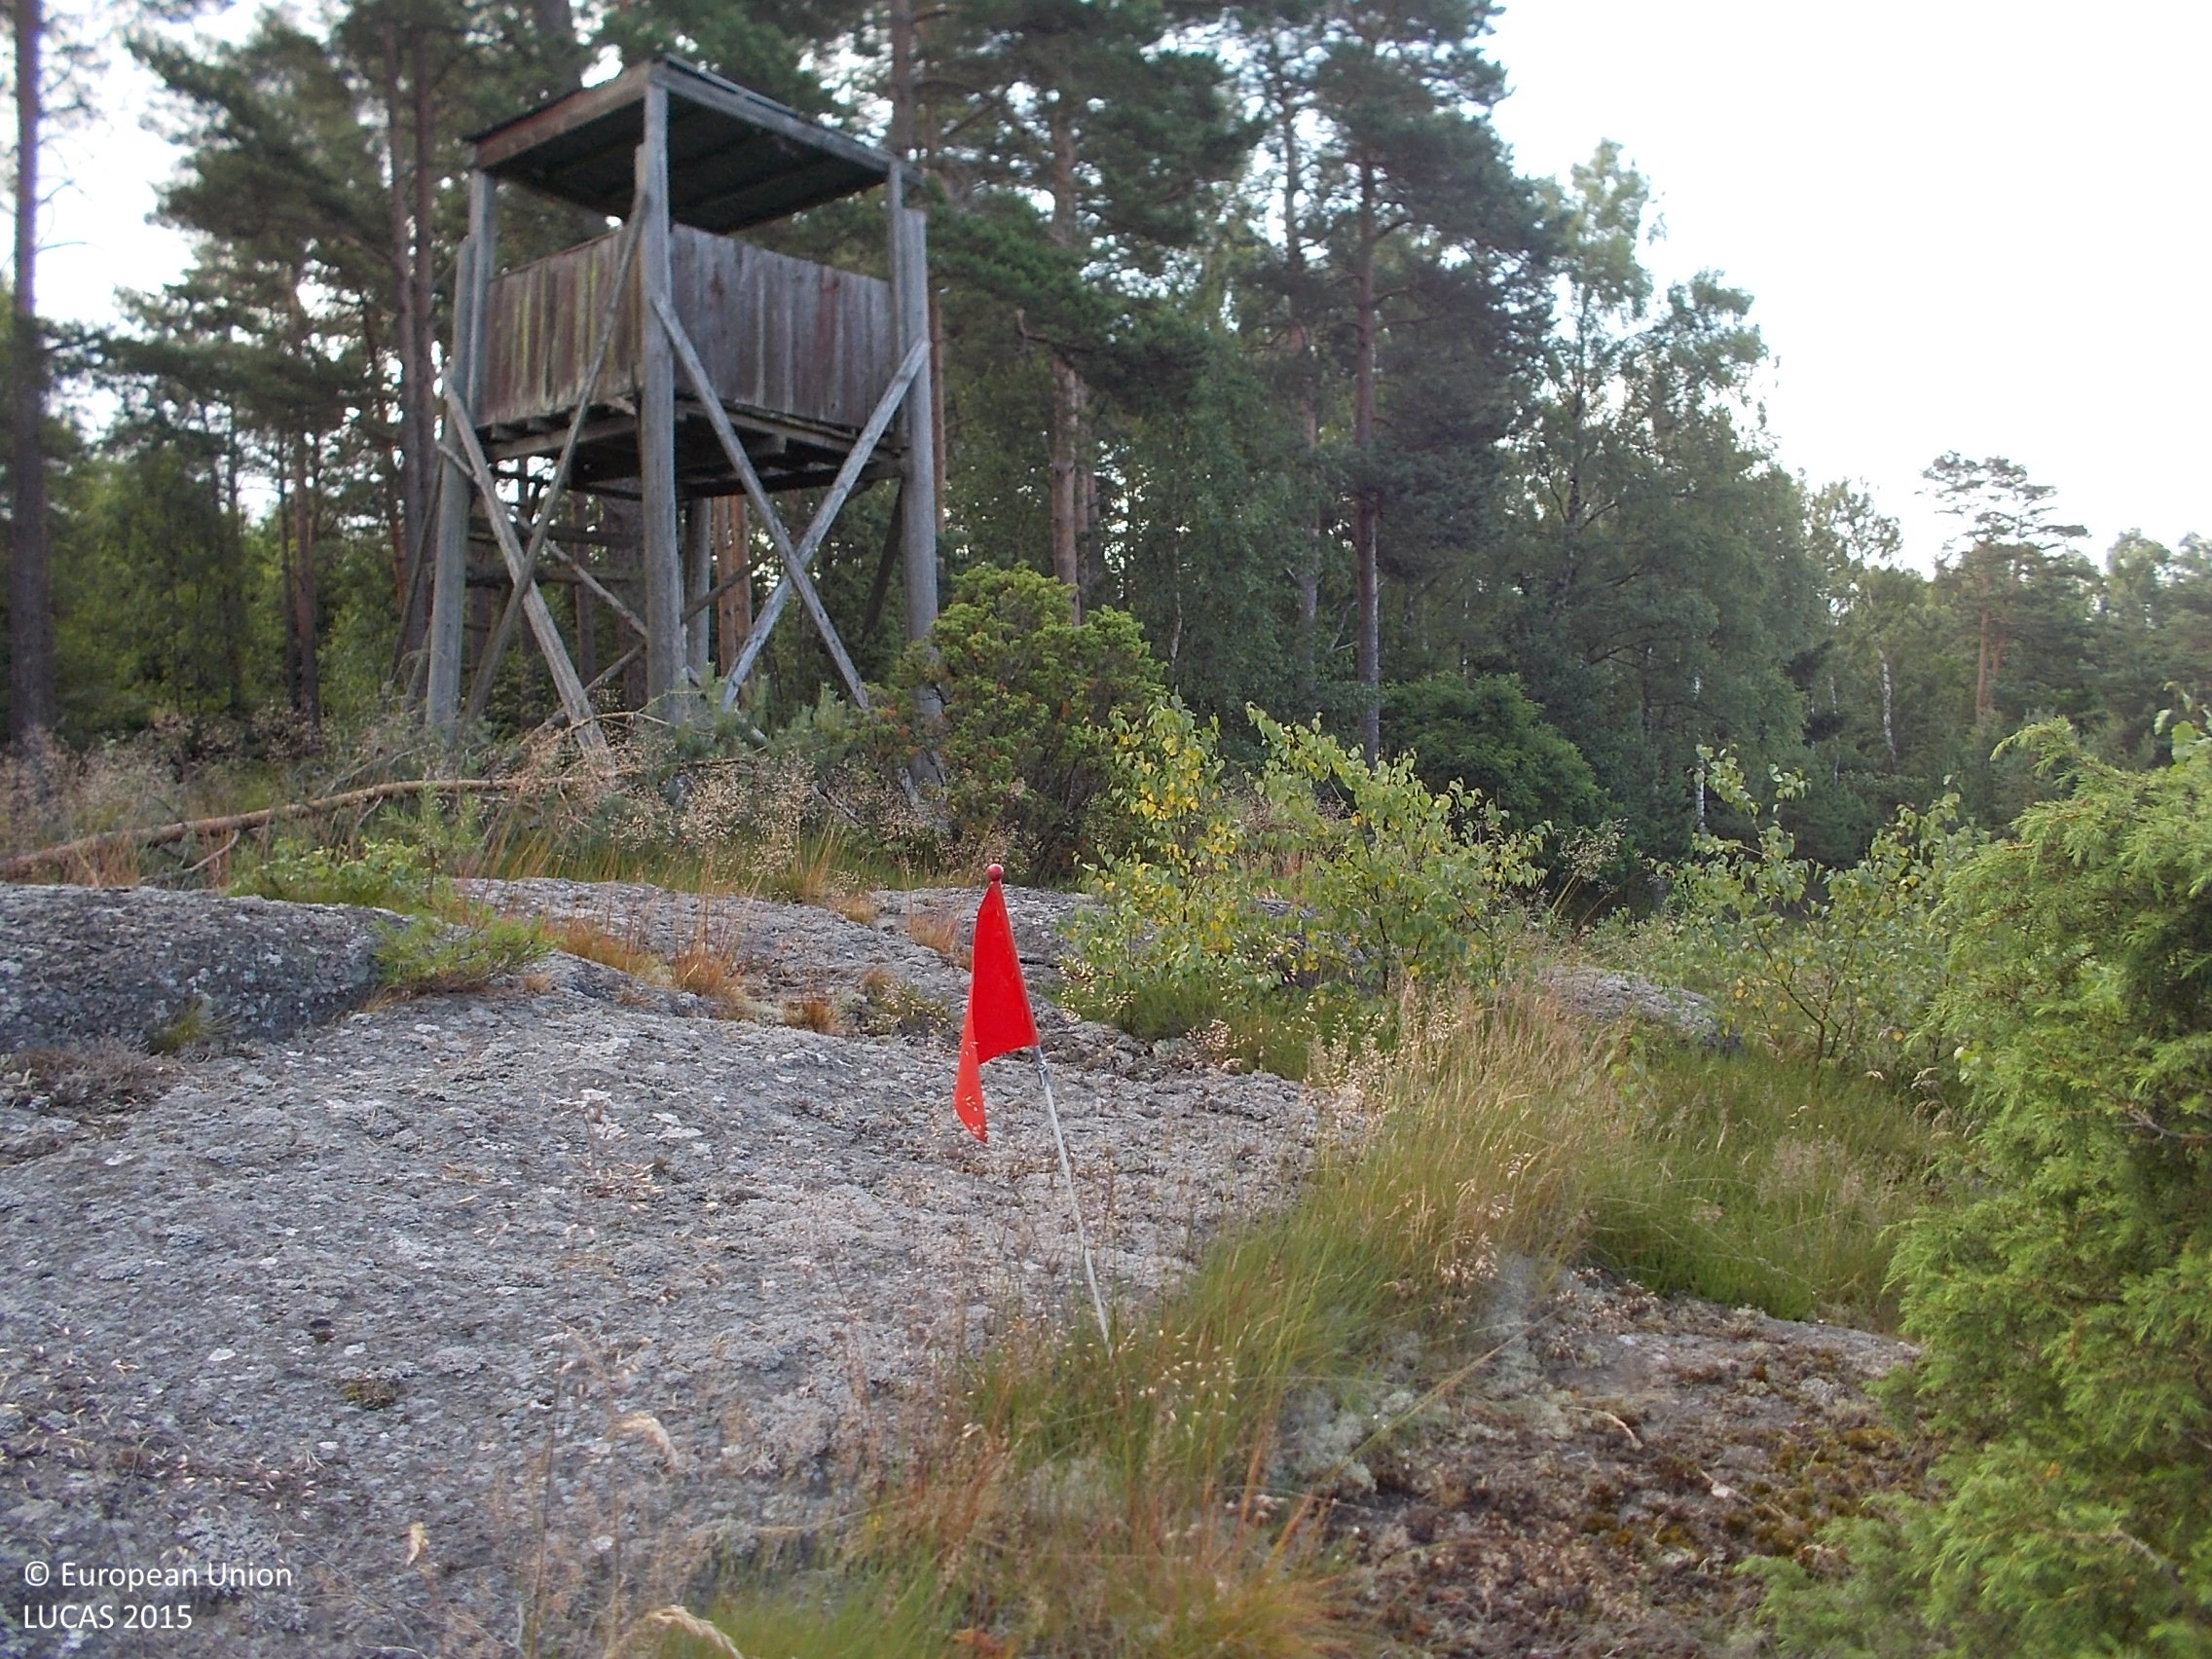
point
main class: Shrubland
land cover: Shrubland with sparse tree cover
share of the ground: > 75 %
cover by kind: shrubs 70 %, herbaceous plants 10 %, lichens and mosses 10 %, broadleaved forest trees 5 %, consolidated bare surface 5 %
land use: Electricity, gas and thermal power distribution
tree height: < 5 m
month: July
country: SE
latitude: 57.1930
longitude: 12.2639
